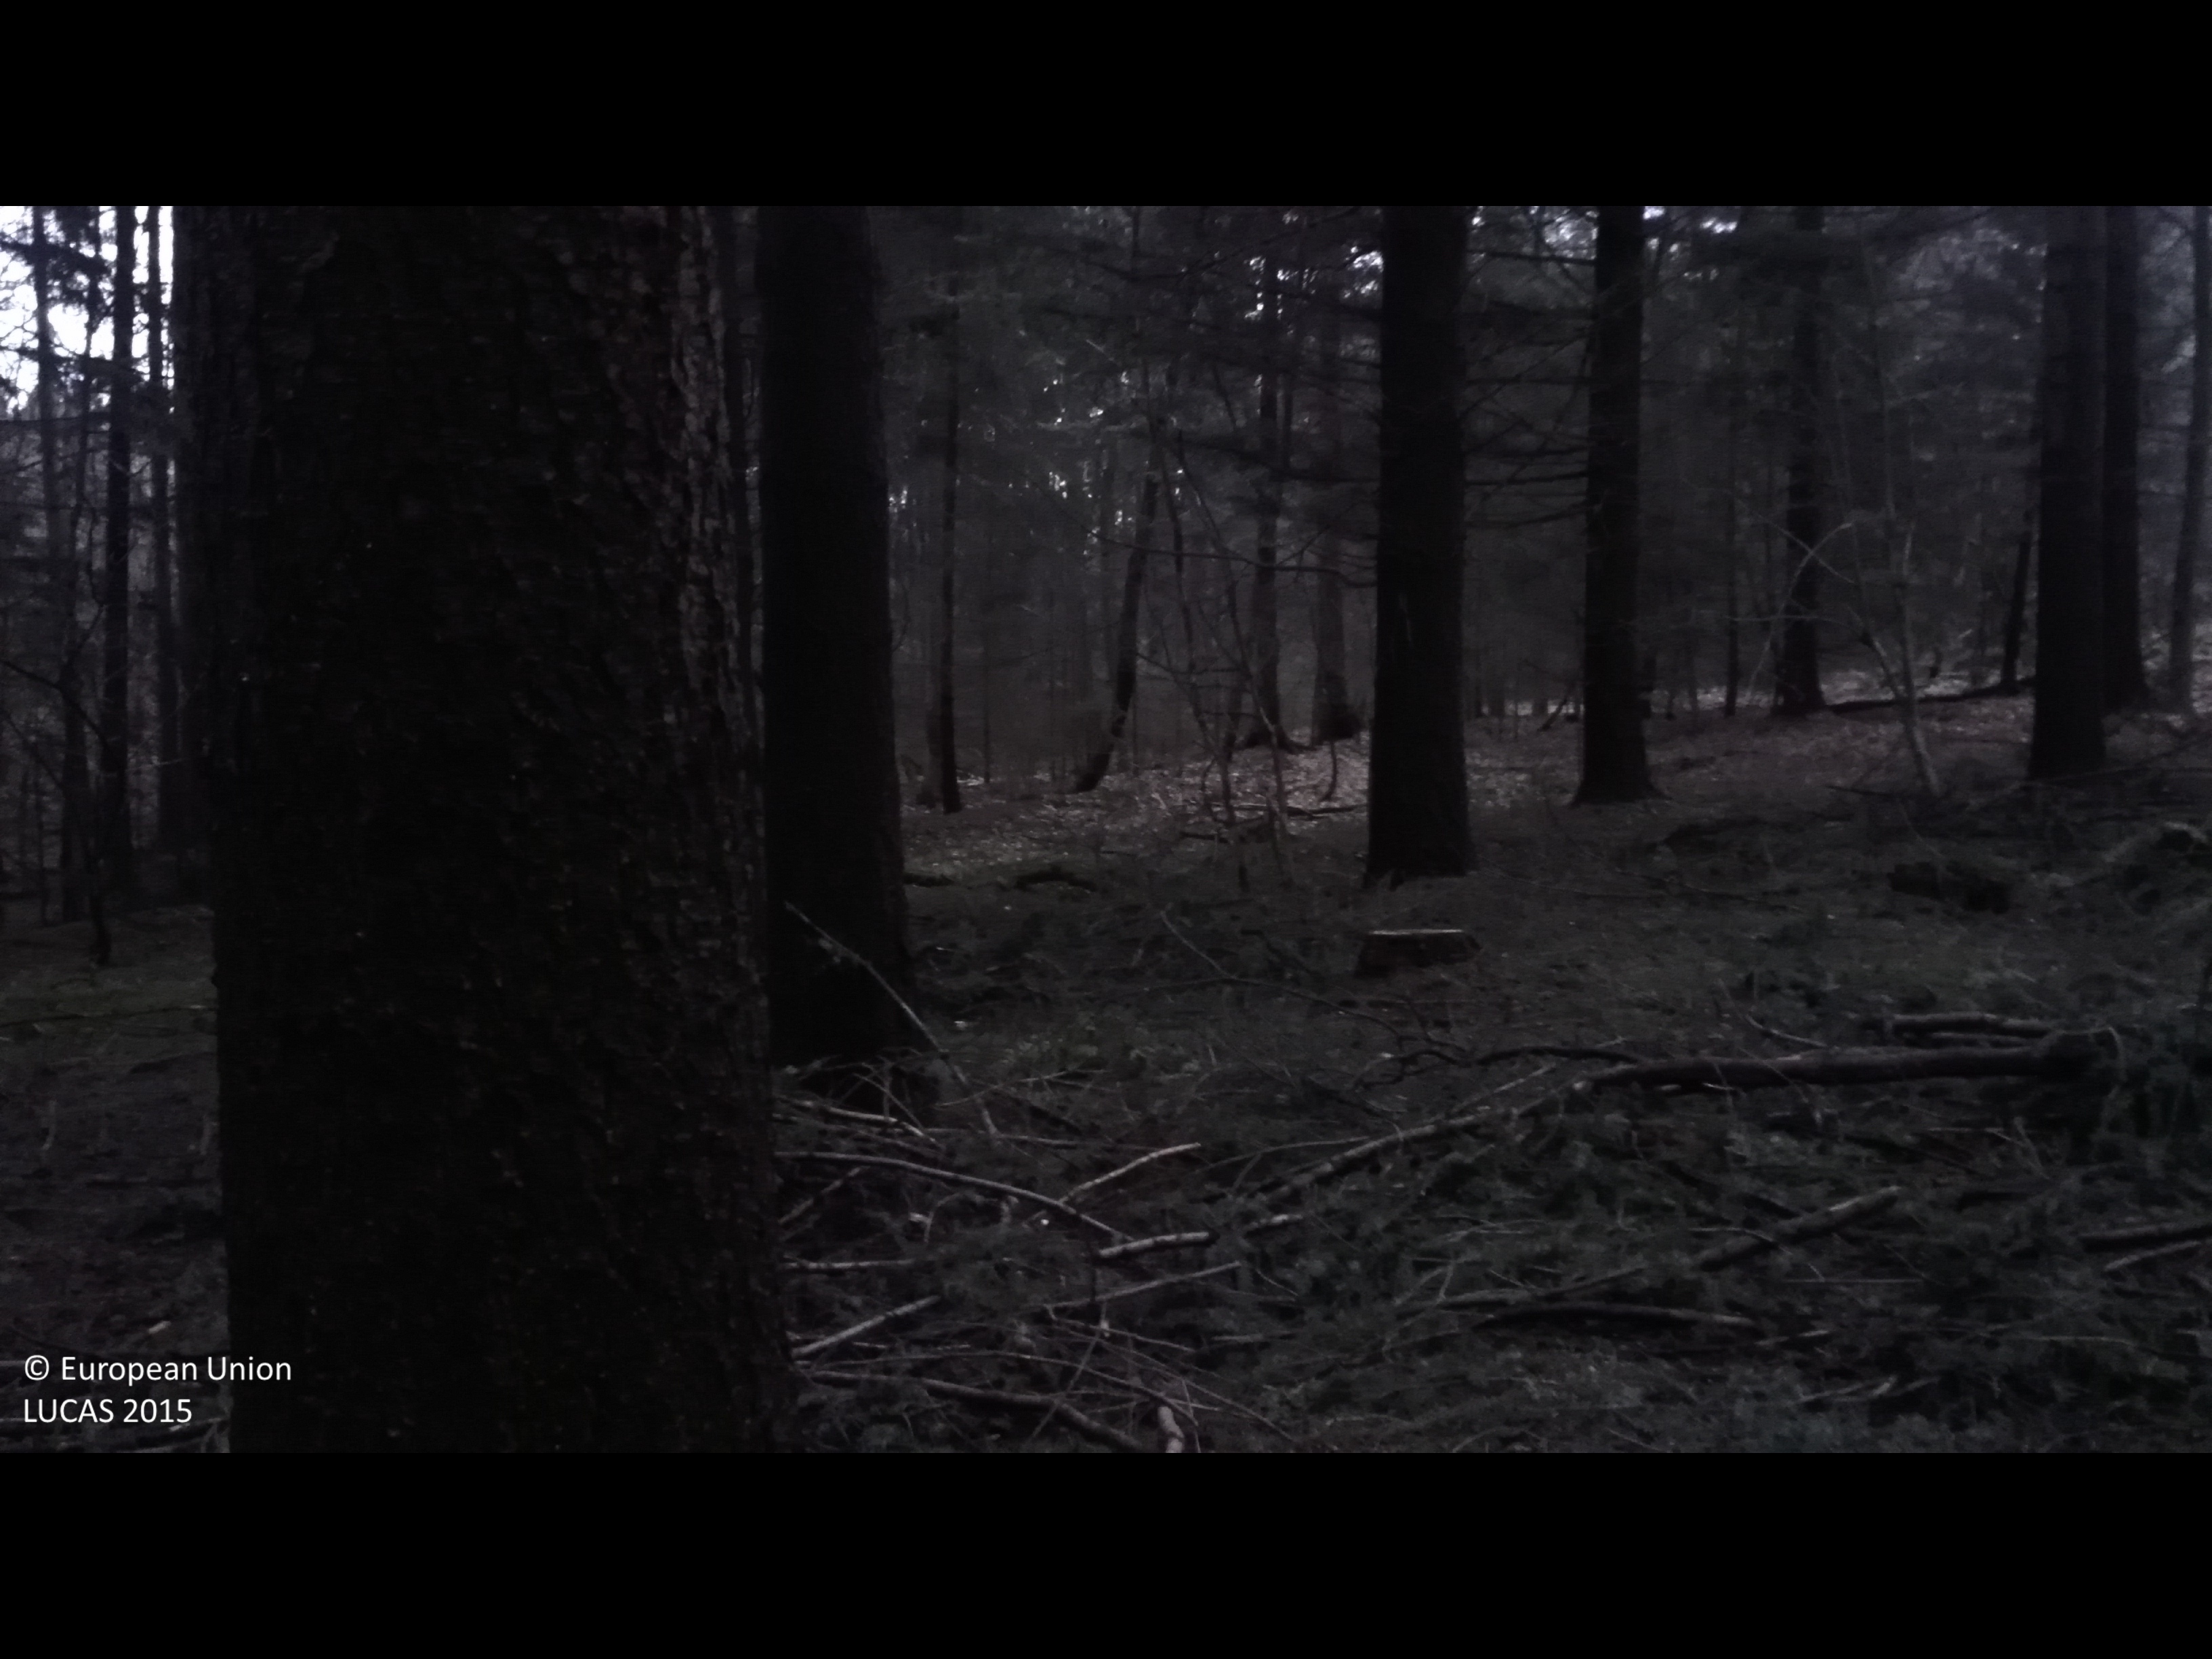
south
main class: Woodland
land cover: Pine dominated coniferous woodland
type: hemiboreal forest and nemoral coniferous forest and mixed broadleaved-coniferous forest
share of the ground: > 75 %
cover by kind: coniferous forest trees 100 %
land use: Forestry
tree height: > 5 m
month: January
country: DE
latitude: 53.4199
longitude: 9.9248
